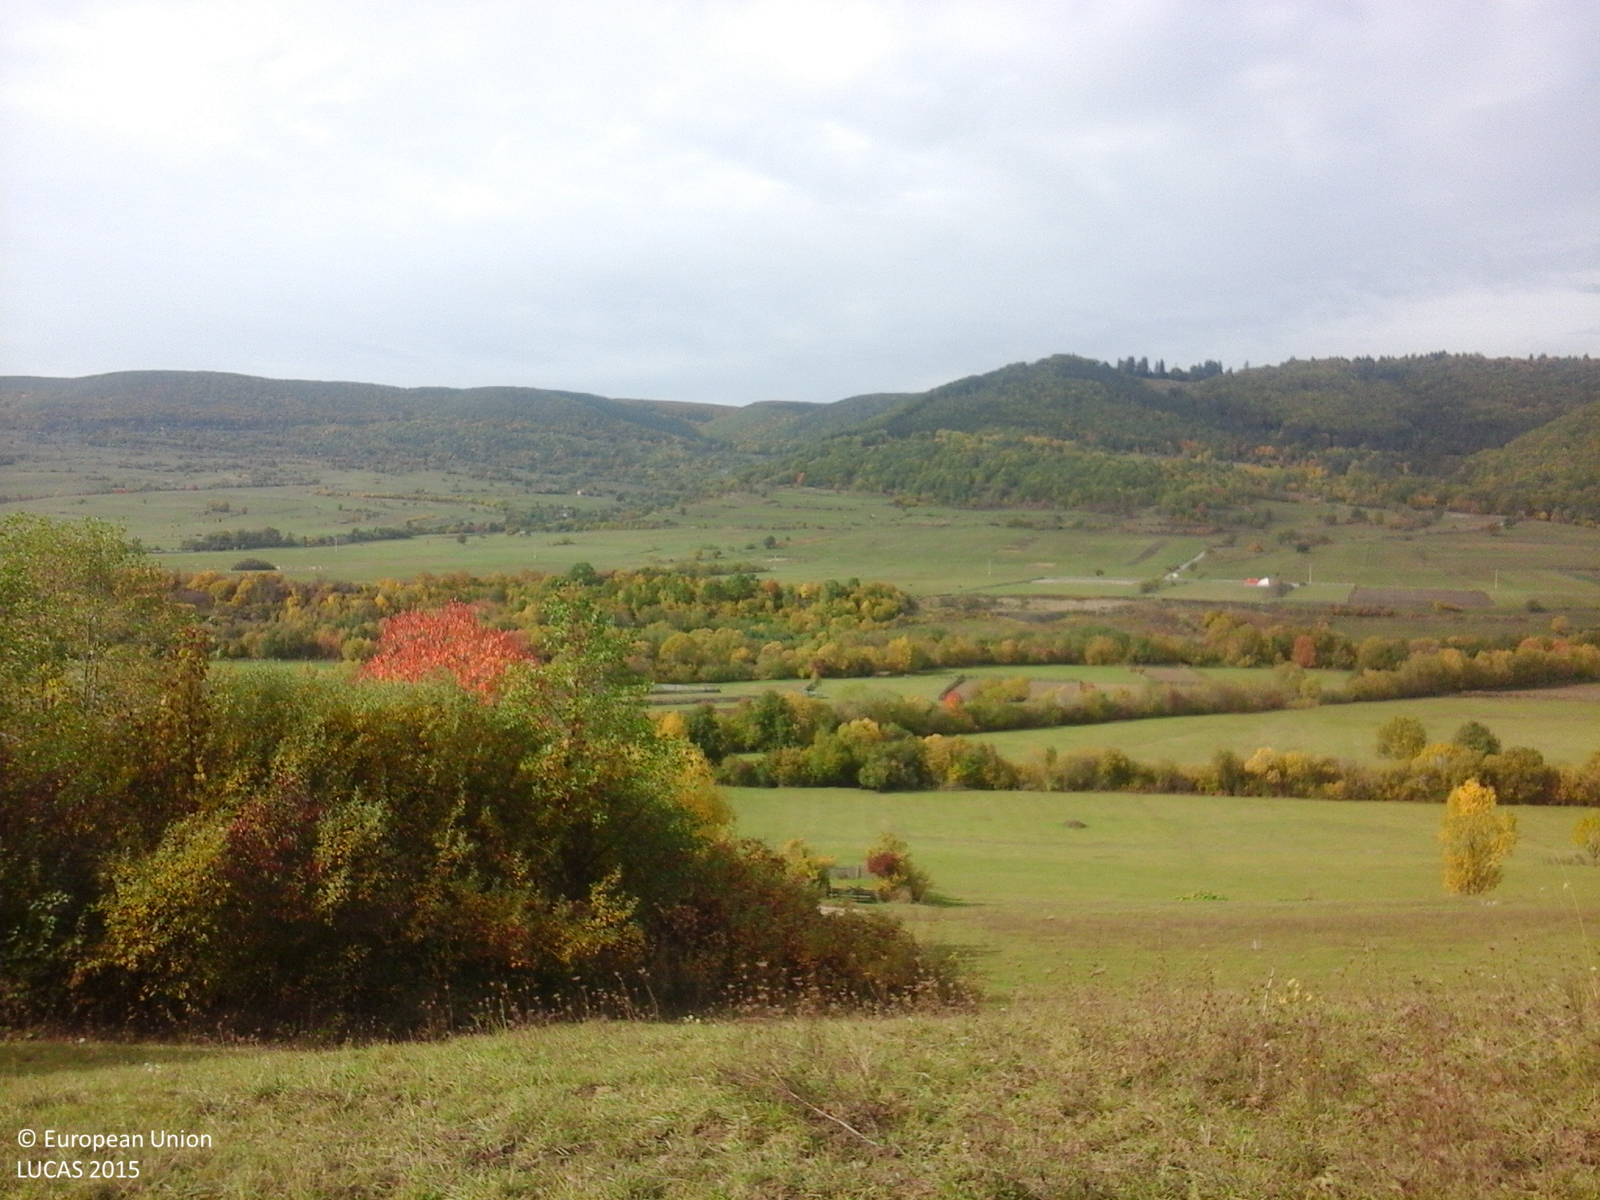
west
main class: Grassland
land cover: Grassland without tree/shrub cover
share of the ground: > 75 %
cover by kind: herbaceous plants 100 %
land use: Agriculture (excluding fallow land and kitchen gardens)
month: October
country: RO
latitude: 46.4194
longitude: 25.3937
